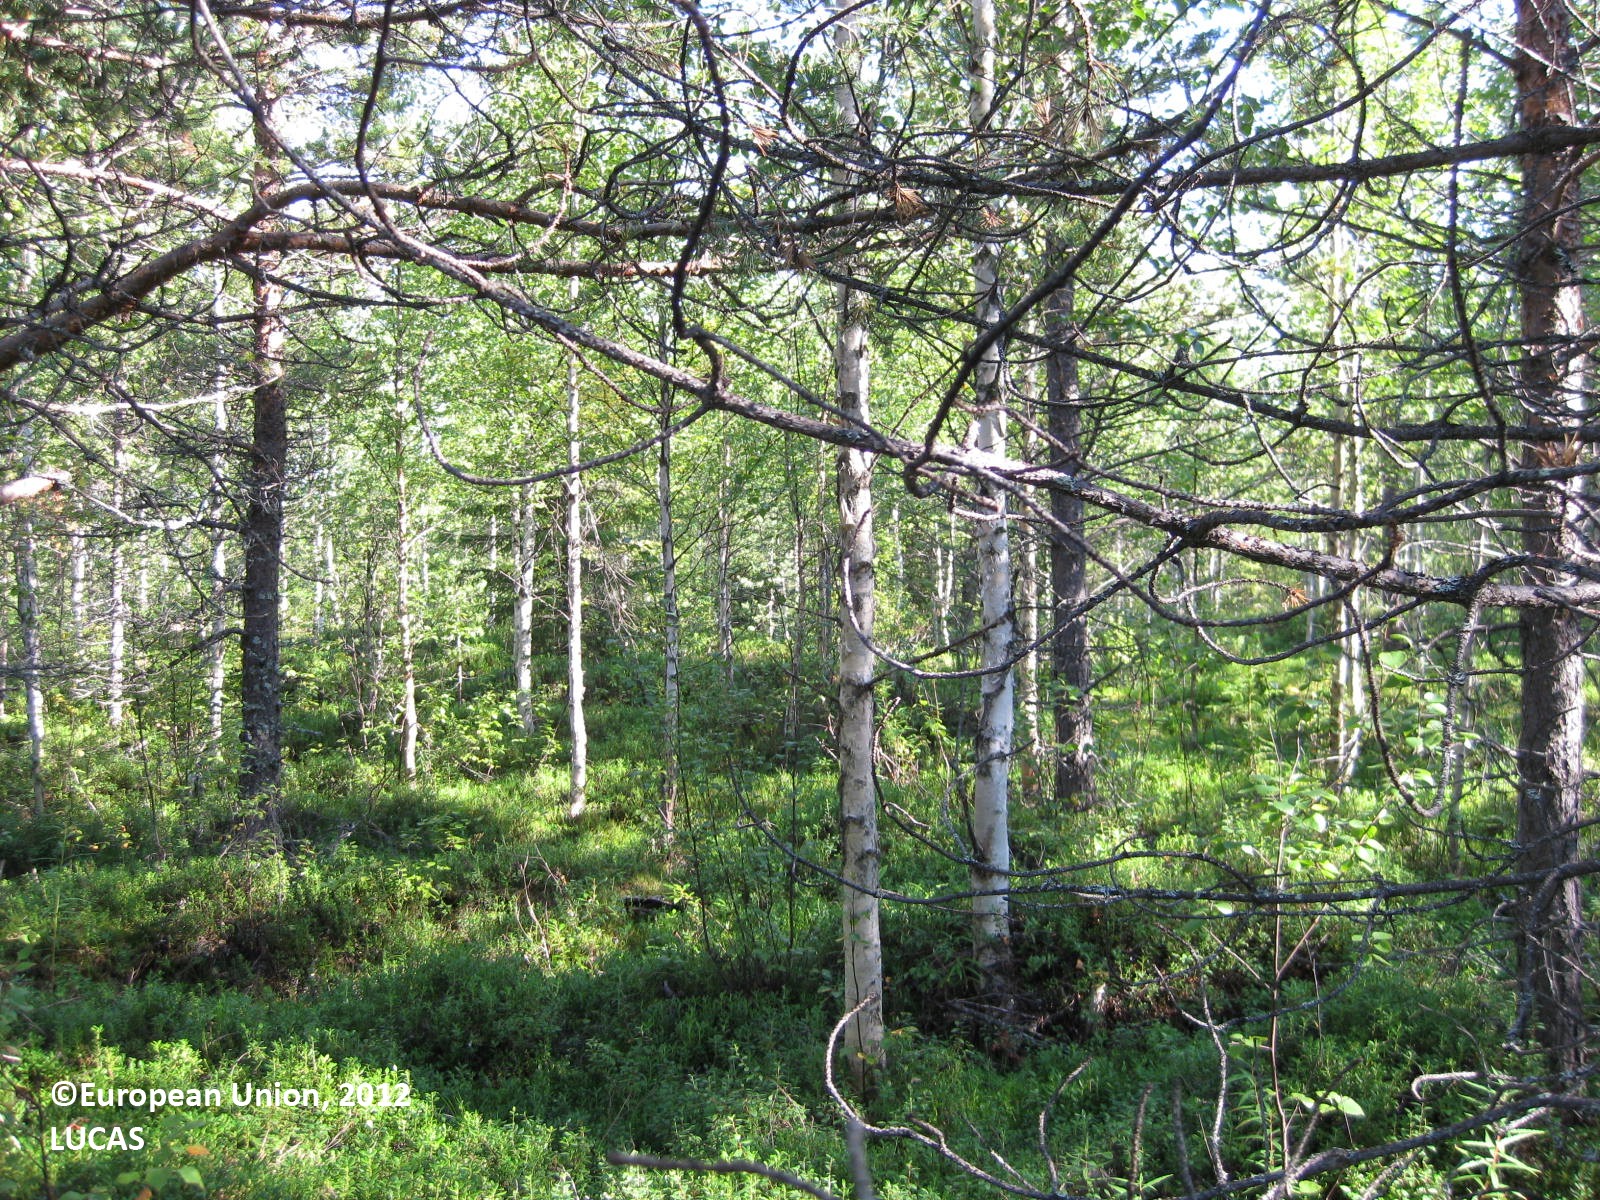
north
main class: Woodland
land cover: Pine dominated mixed woodland
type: boreal forest
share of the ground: > 75 %
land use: Forestry
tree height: > 5 m
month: August
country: FI
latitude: 66.6641
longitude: 29.1464
